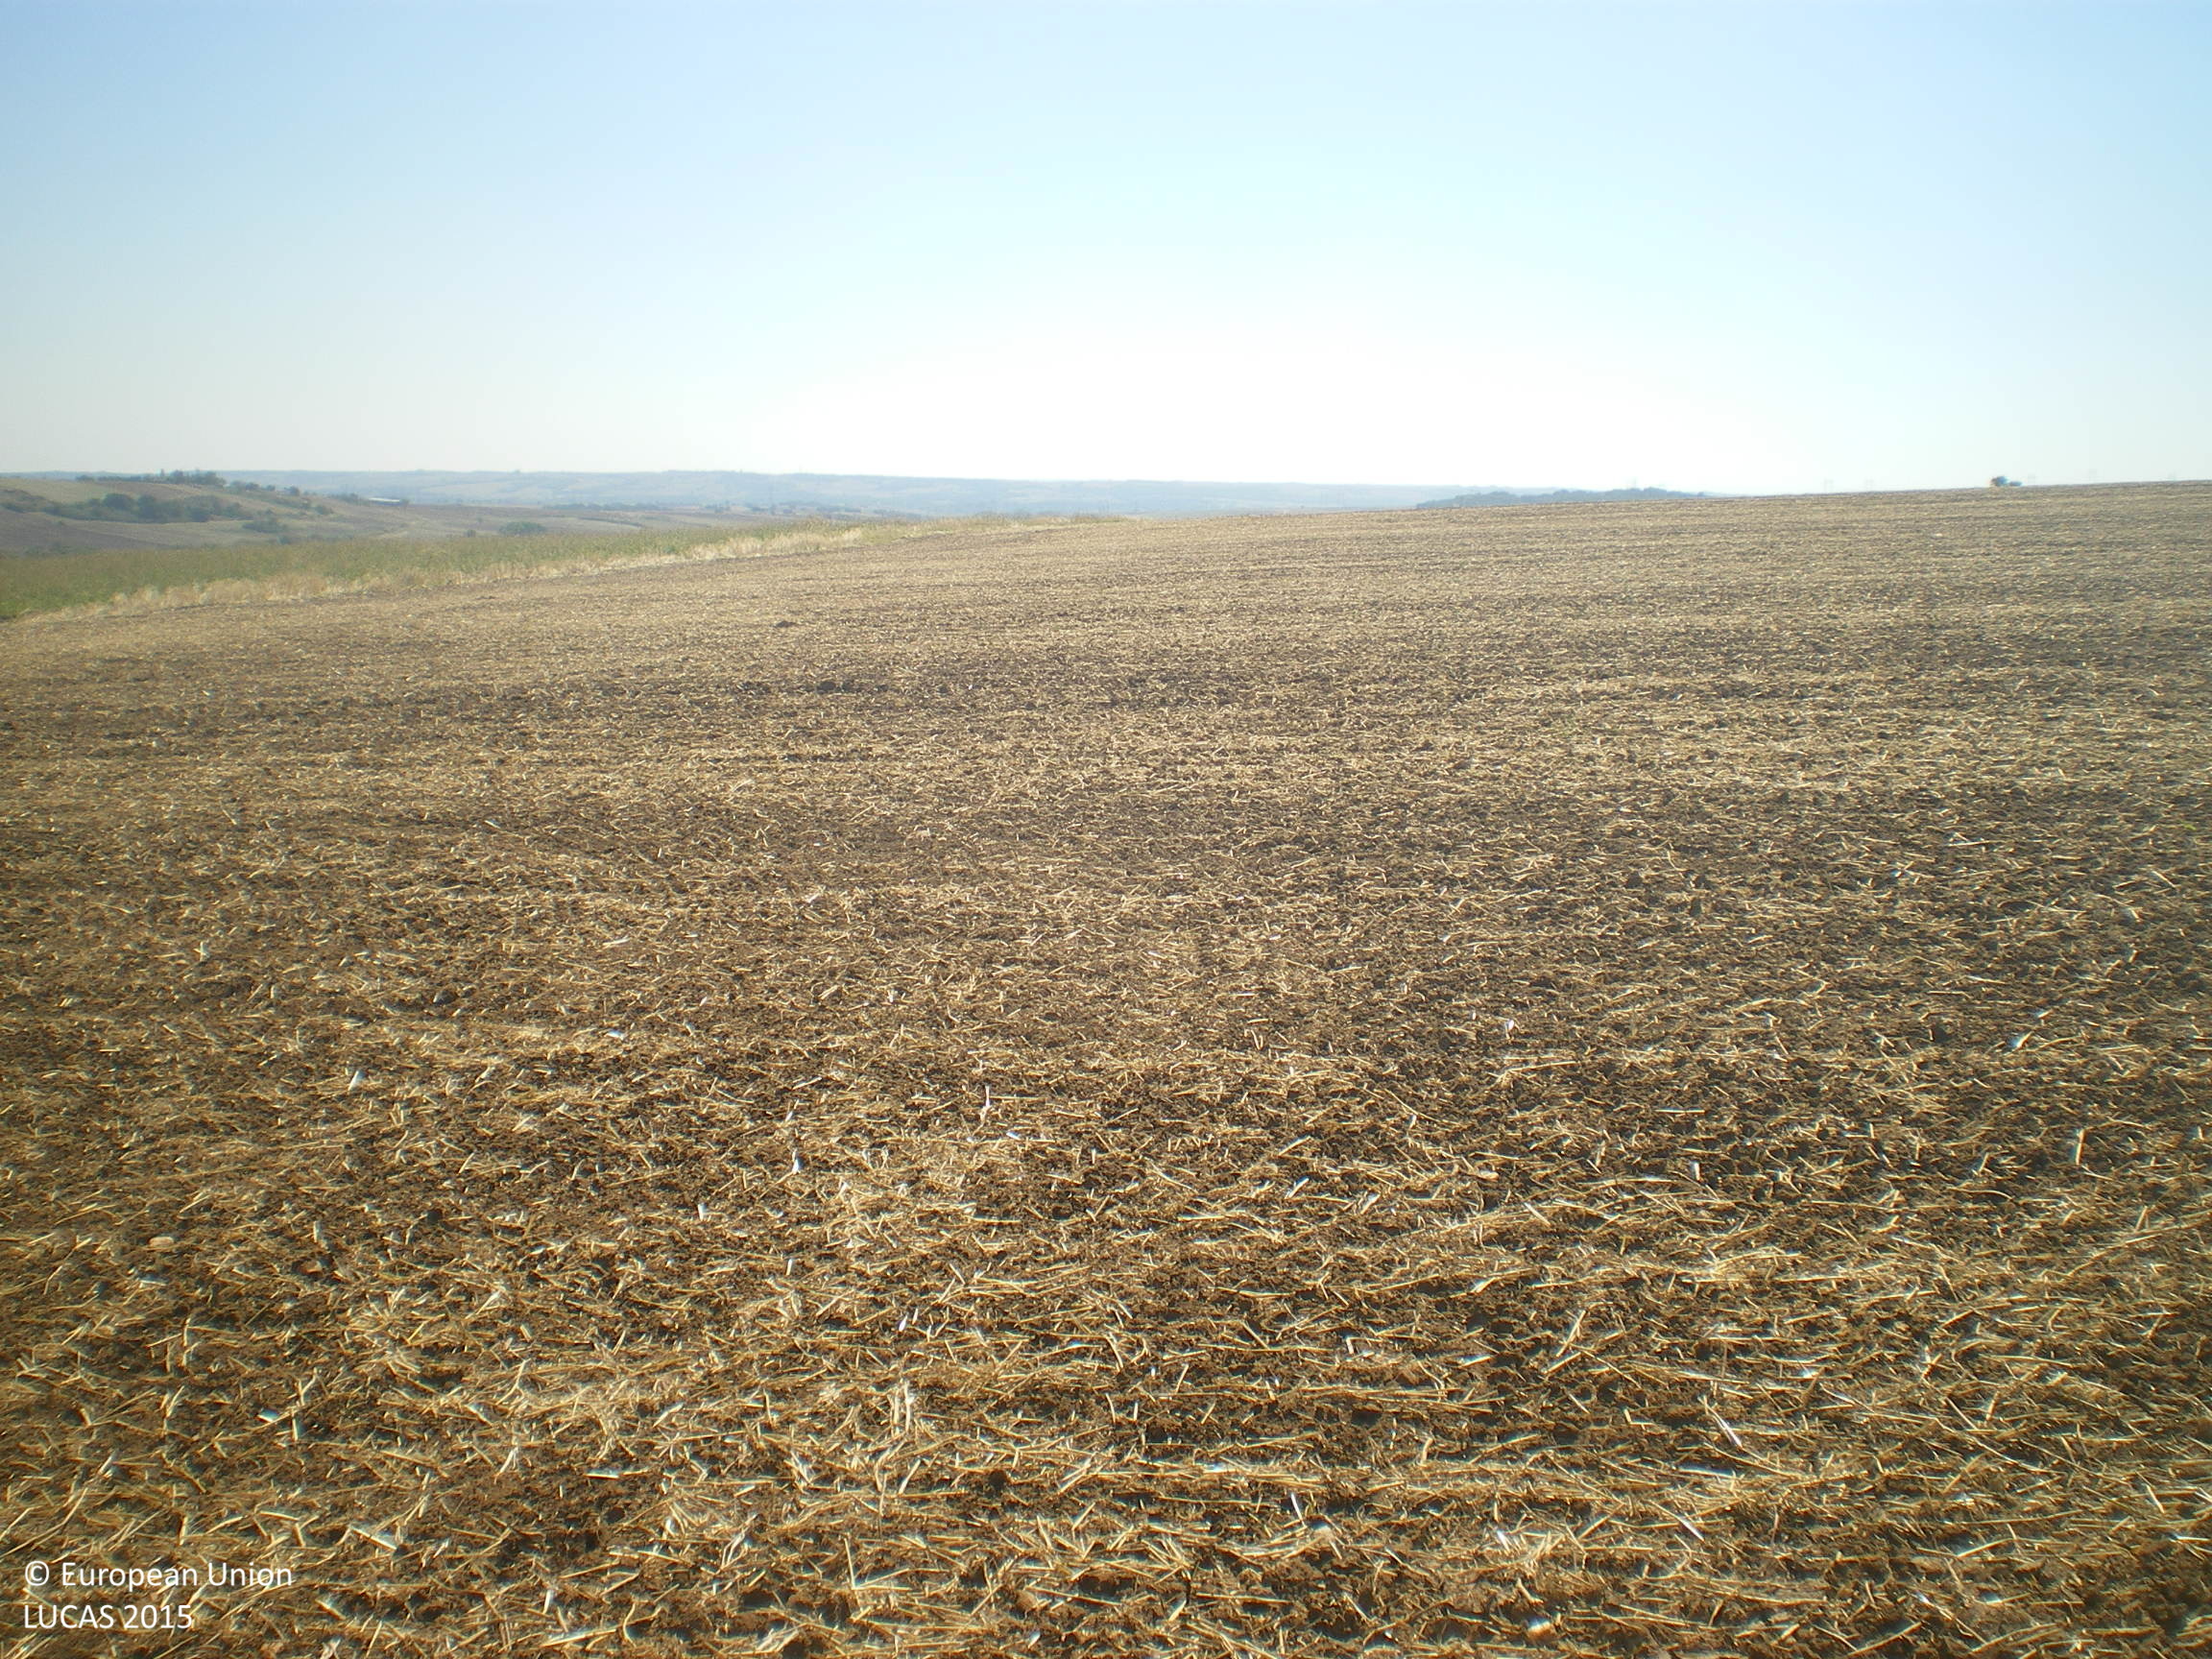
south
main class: Cropland
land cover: Common wheat
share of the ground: < 10 %
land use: Agriculture (excluding fallow land and kitchen gardens)
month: September
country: BG
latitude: 41.7775
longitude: 26.3327
